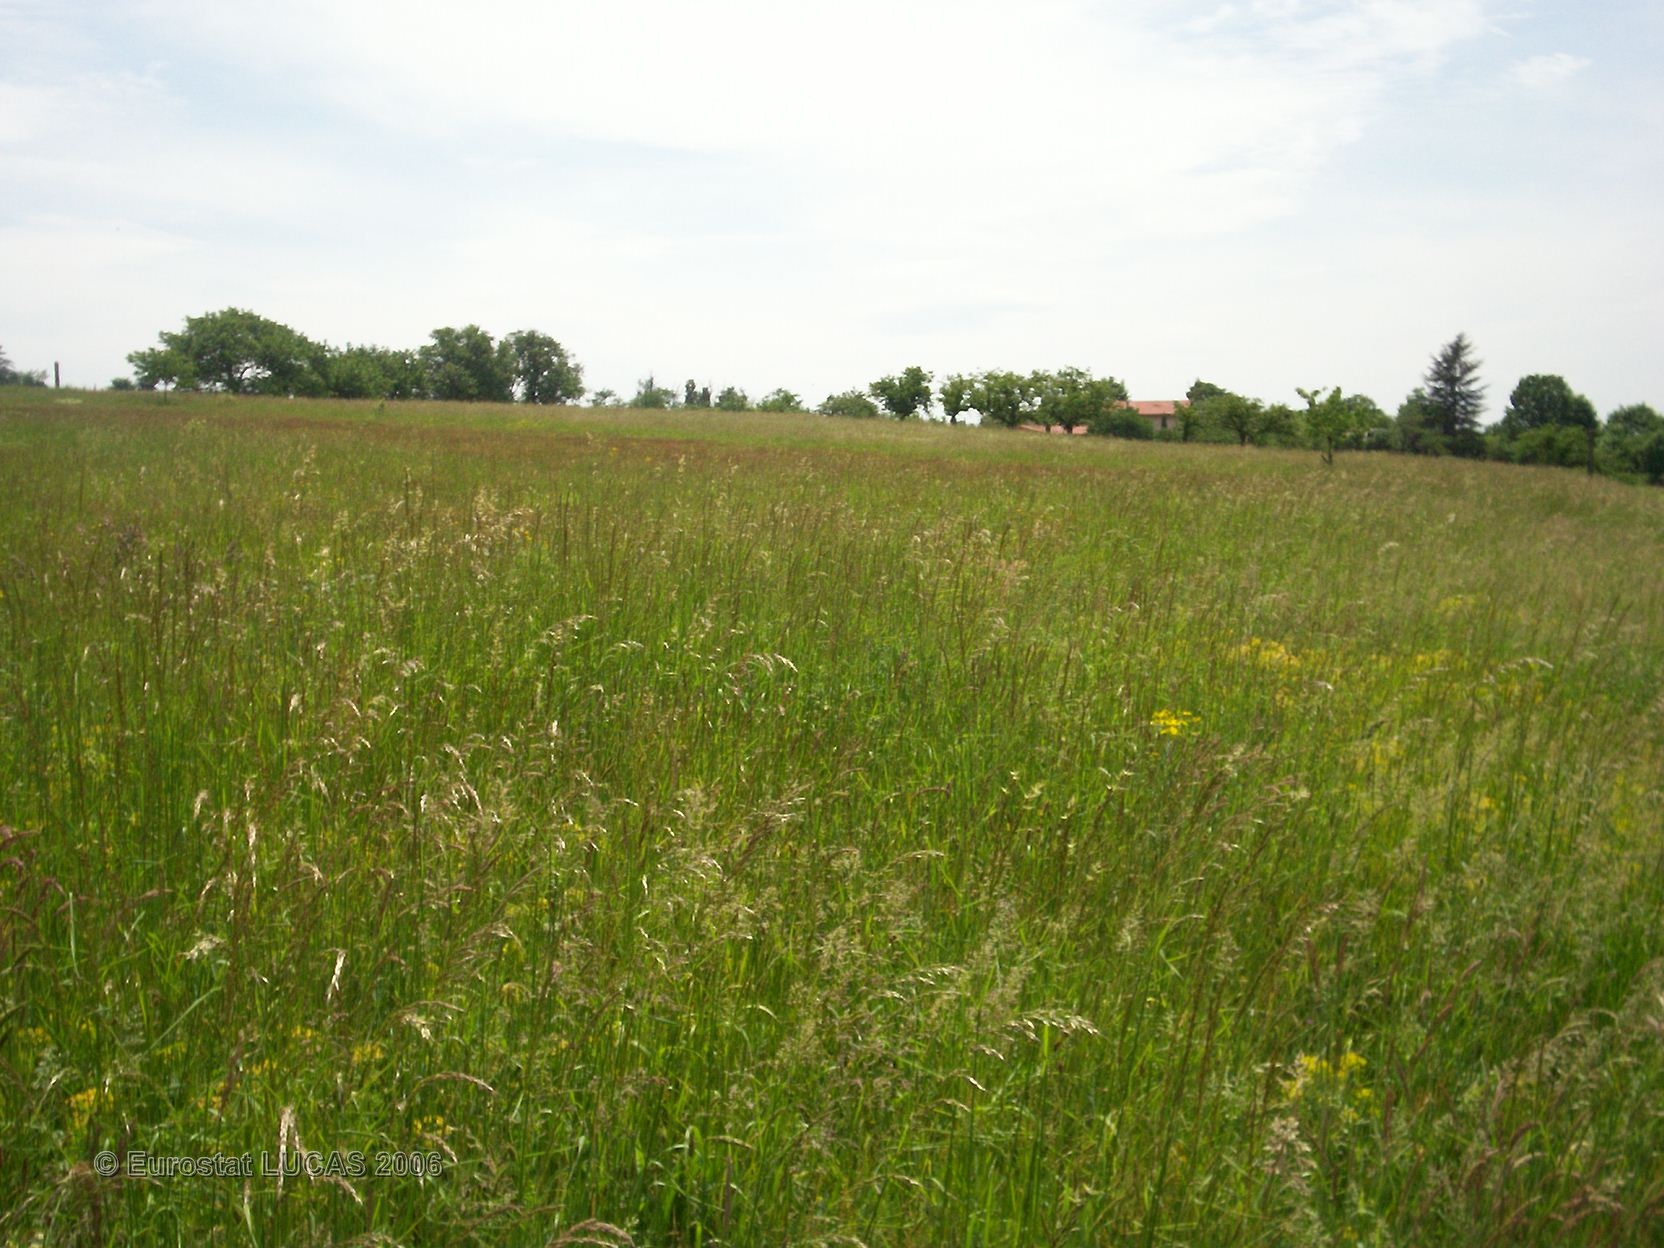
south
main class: Grassland
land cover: Grassland without tree/shrub cover
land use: Agriculture (excluding fallow land and kitchen gardens)
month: May
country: FR
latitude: 45.7001
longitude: 4.7764
